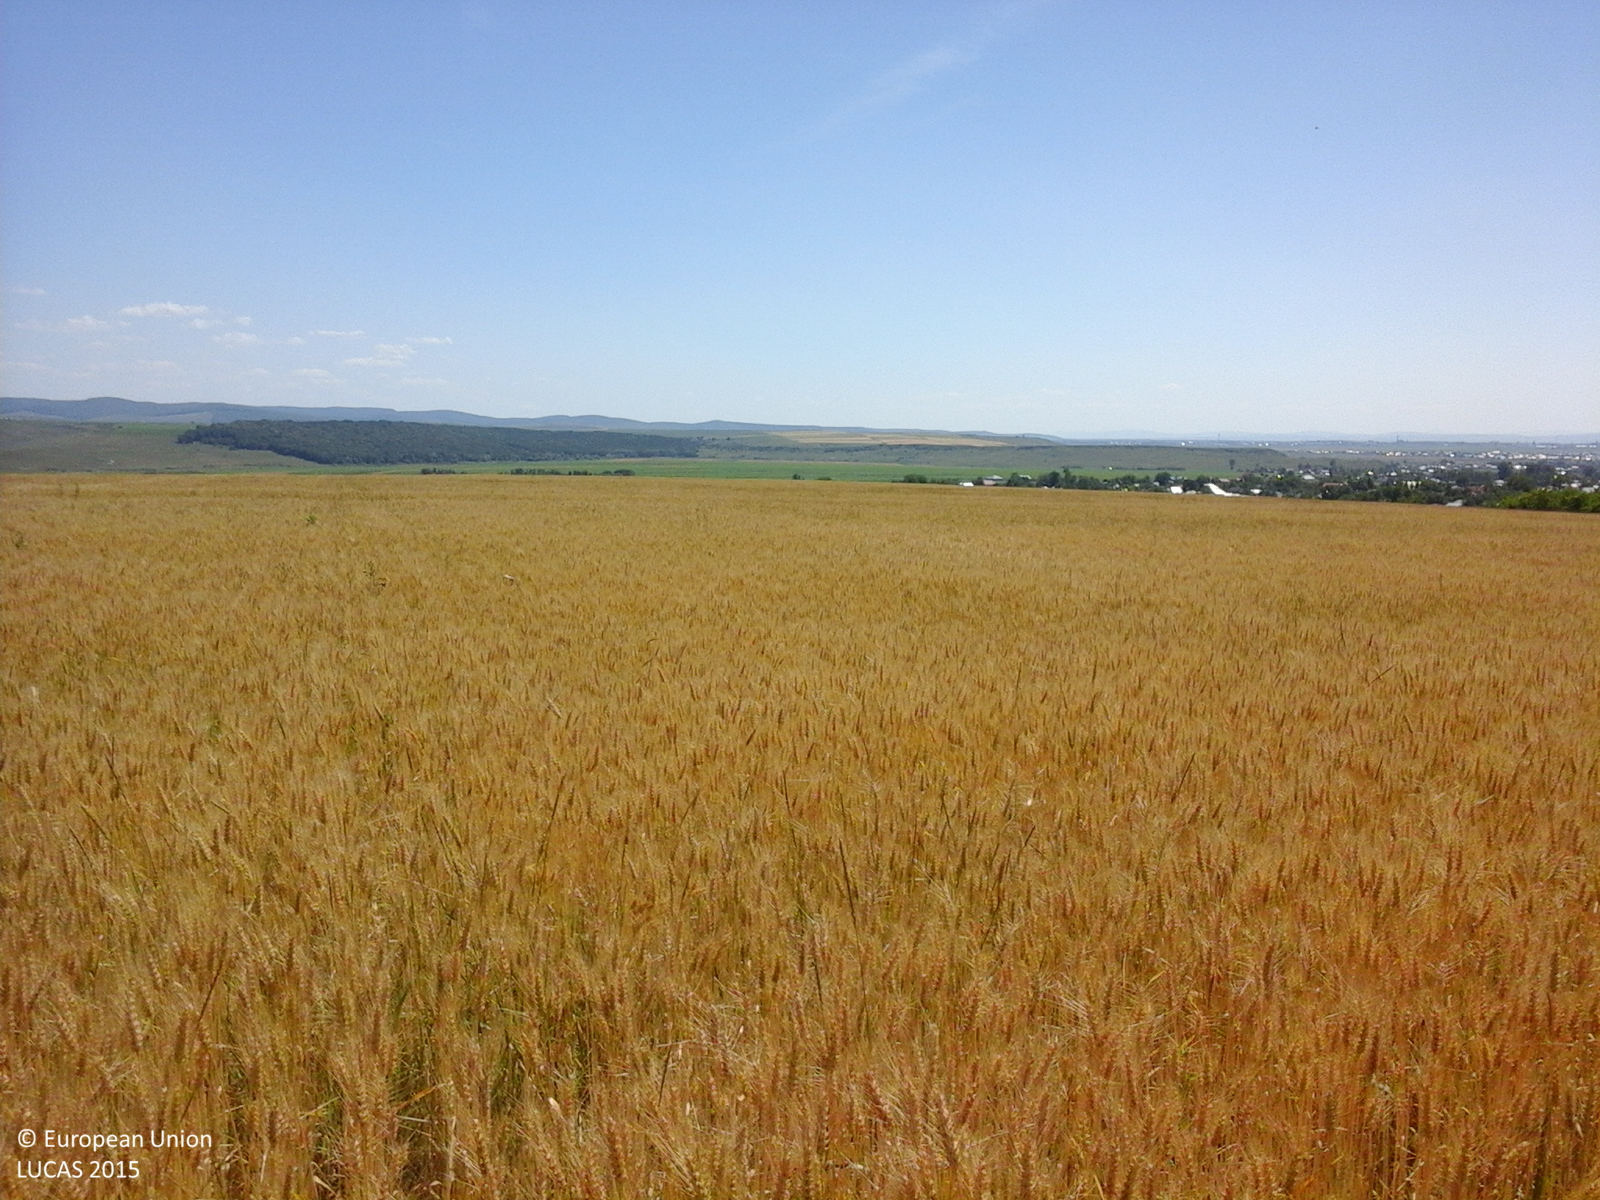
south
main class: Cropland
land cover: Common wheat
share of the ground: > 75 %
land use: Agriculture (excluding fallow land and kitchen gardens)
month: June
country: RO
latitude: 47.0571
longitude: 26.9906
